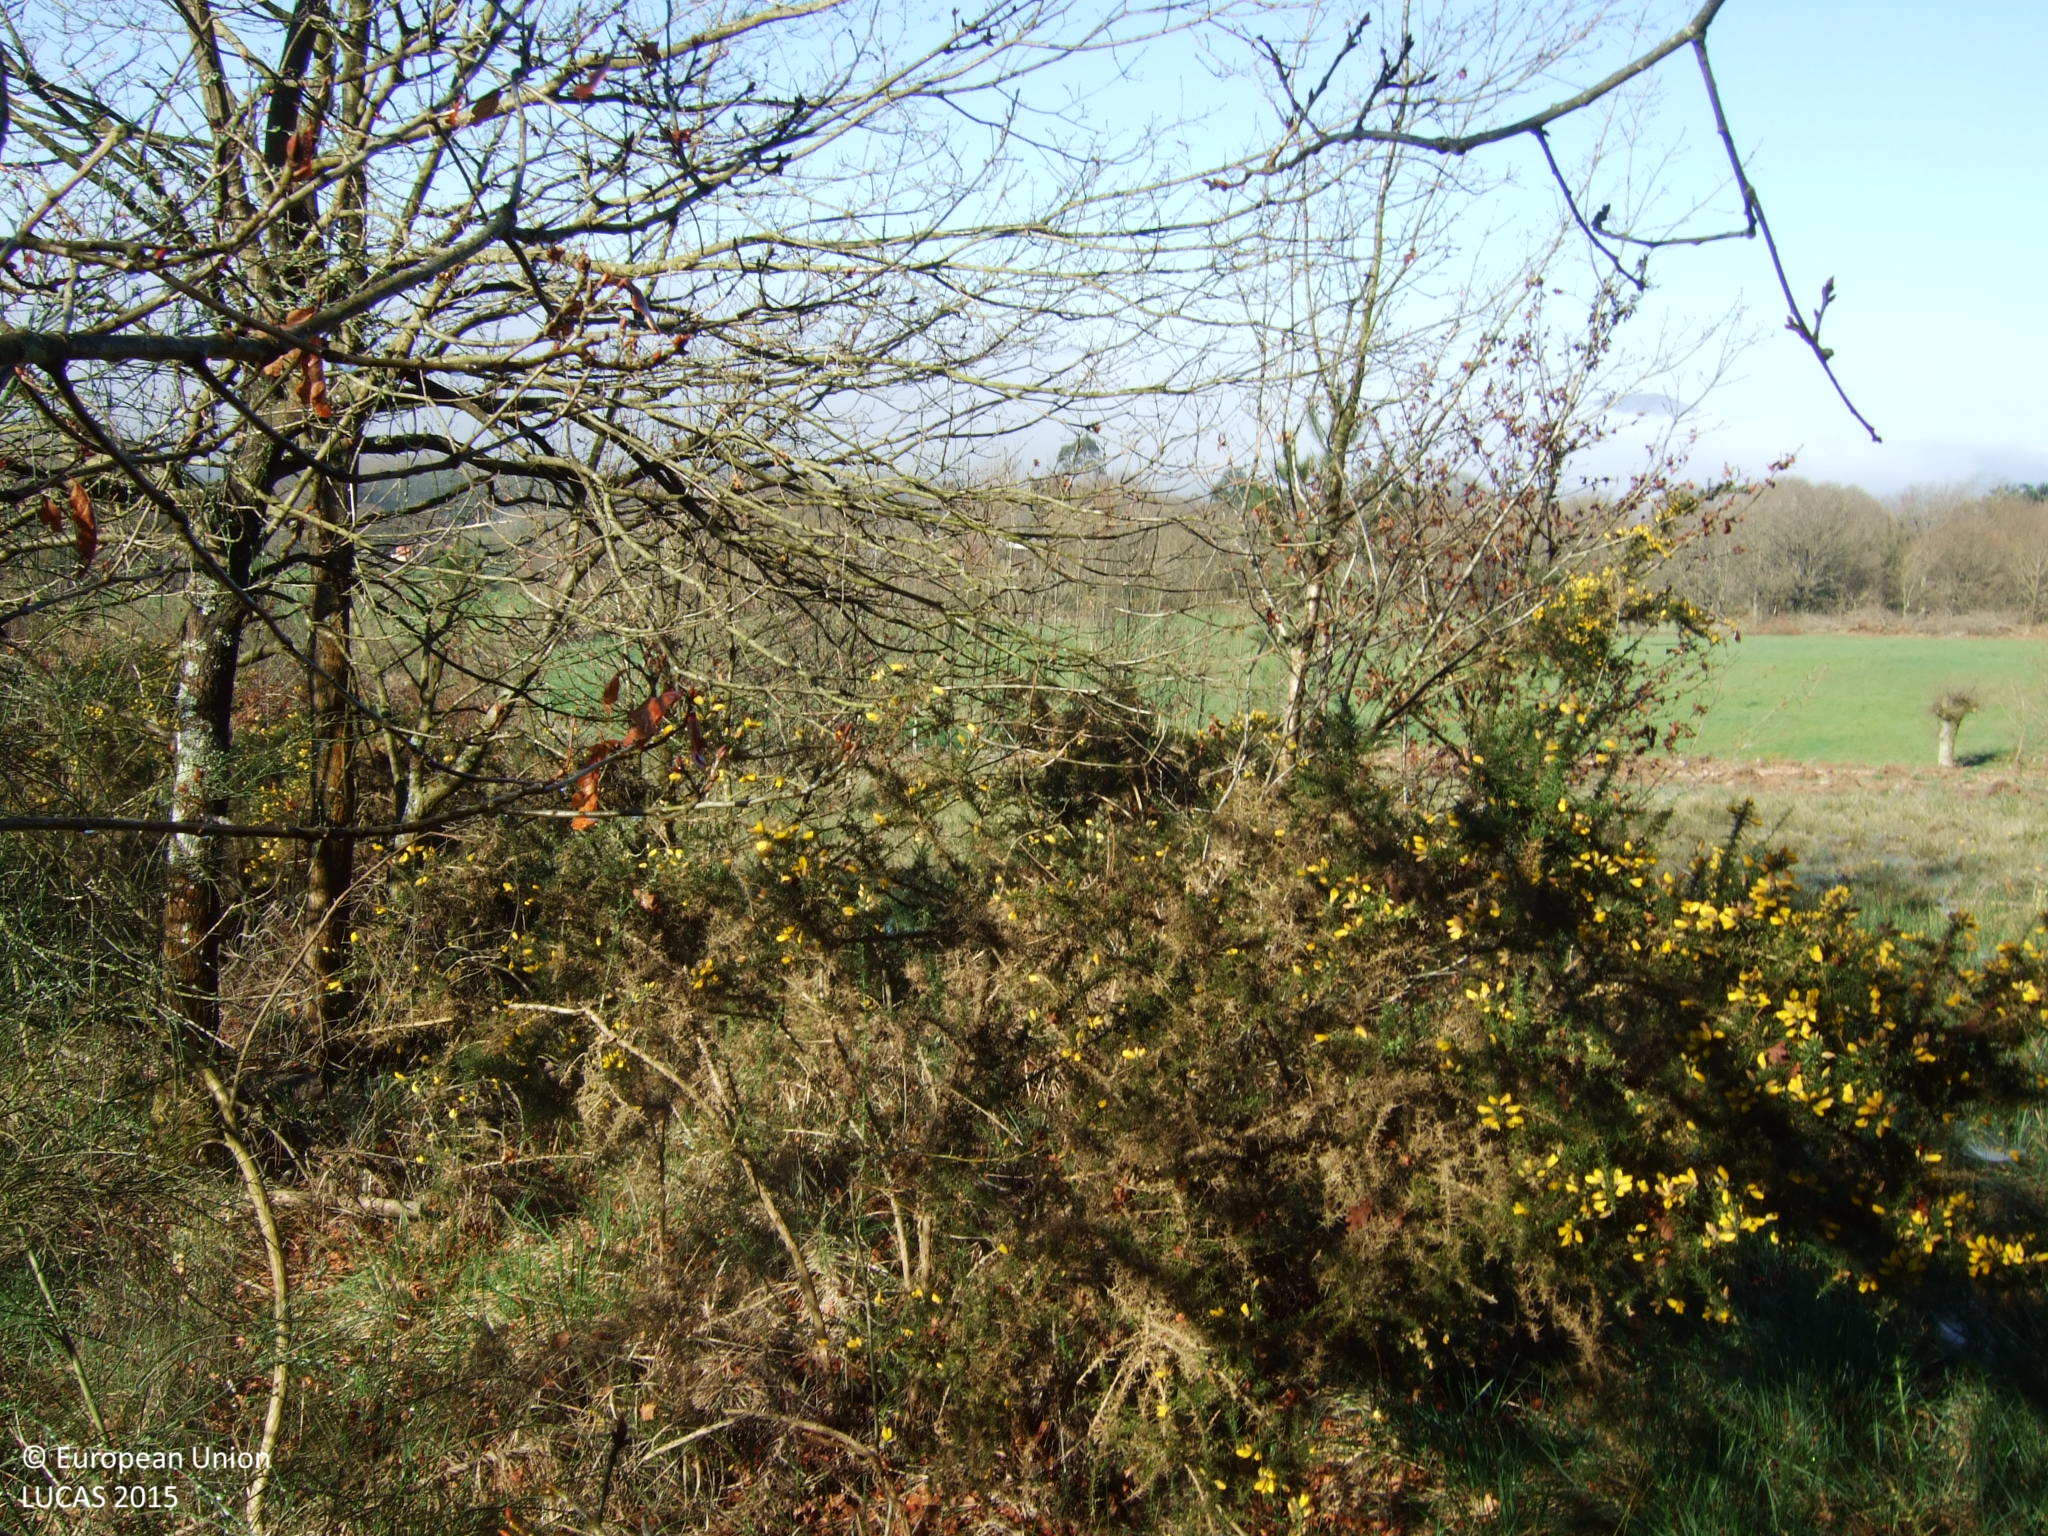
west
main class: Woodland
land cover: Broadleaved woodland
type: acidophilous oak and oak-birch forest
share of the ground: 10 - 25 %
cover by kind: shrubs 50 %, herbaceous plants 30 %, broadleaved forest trees 20 %
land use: Semi-natural and natural areas not in use
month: April
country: ES
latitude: 42.7617
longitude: -7.7868
